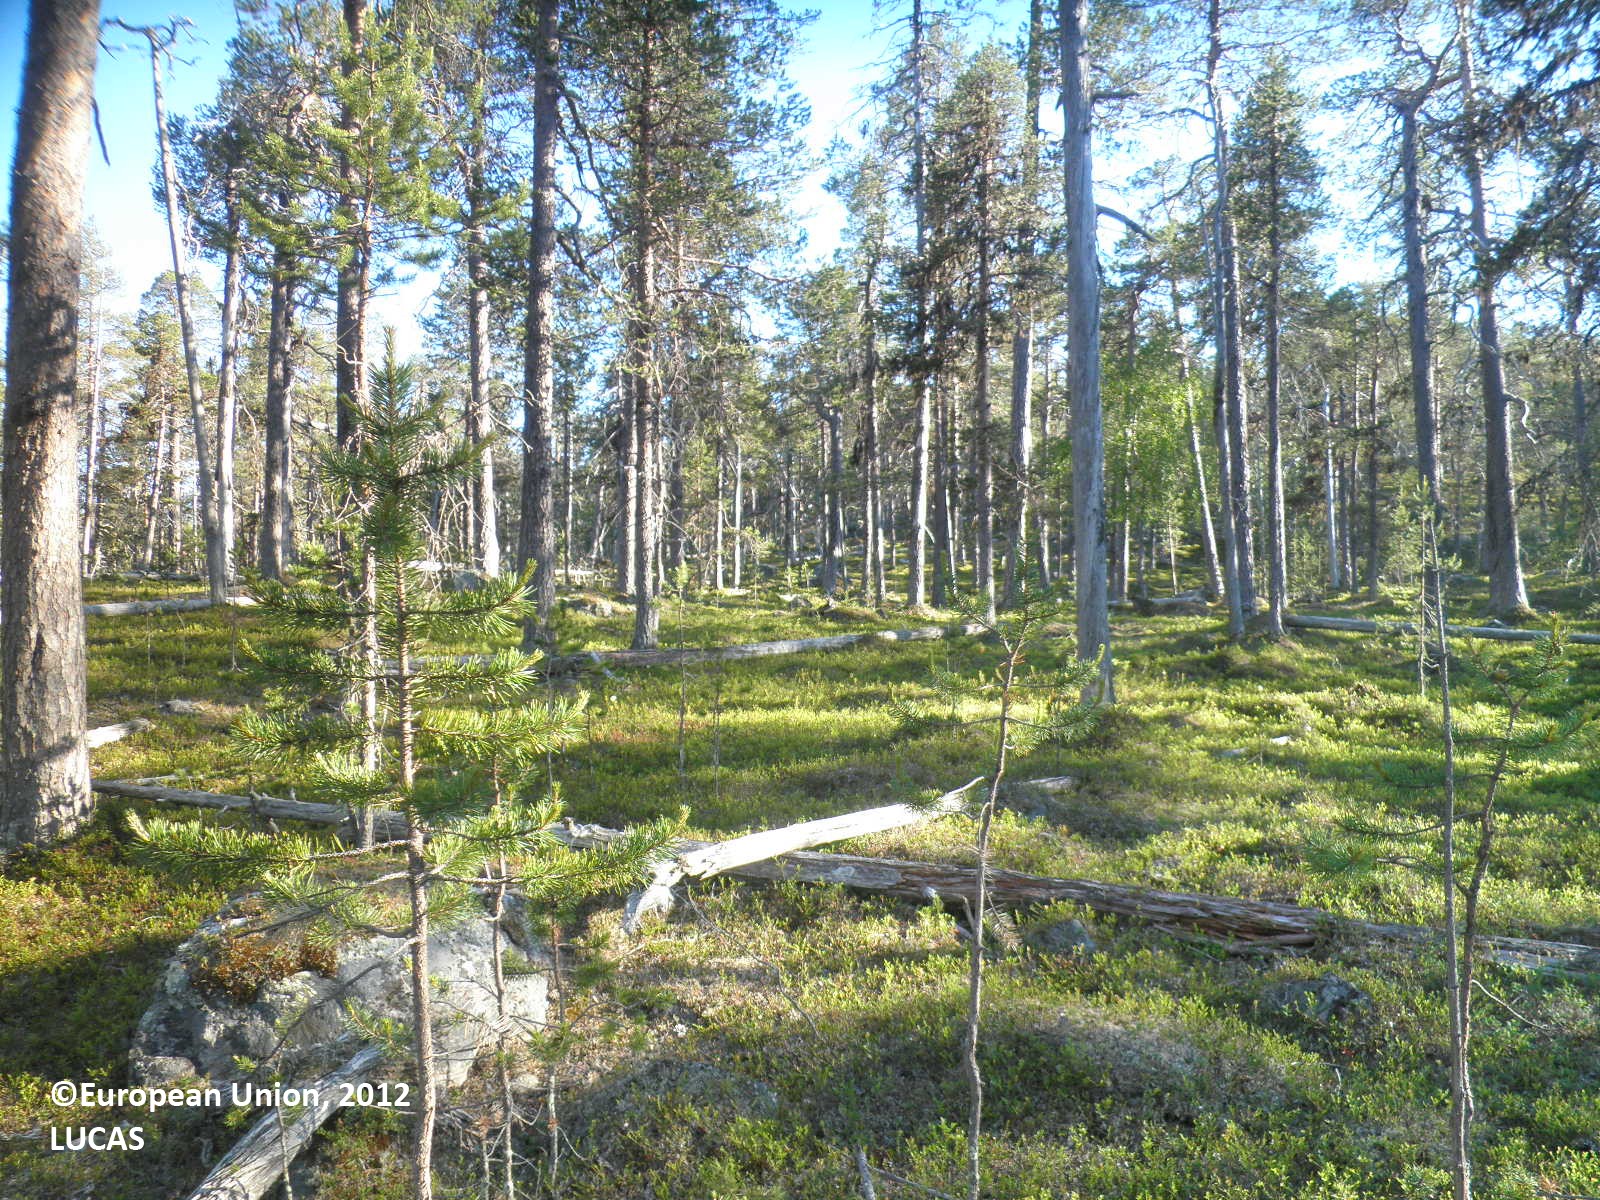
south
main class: Woodland
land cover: Pine dominated coniferous woodland
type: boreal forest
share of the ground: 50 - 75 %
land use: Forestry
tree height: > 5 m
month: July
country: FI
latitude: 68.7572
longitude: 27.2568
